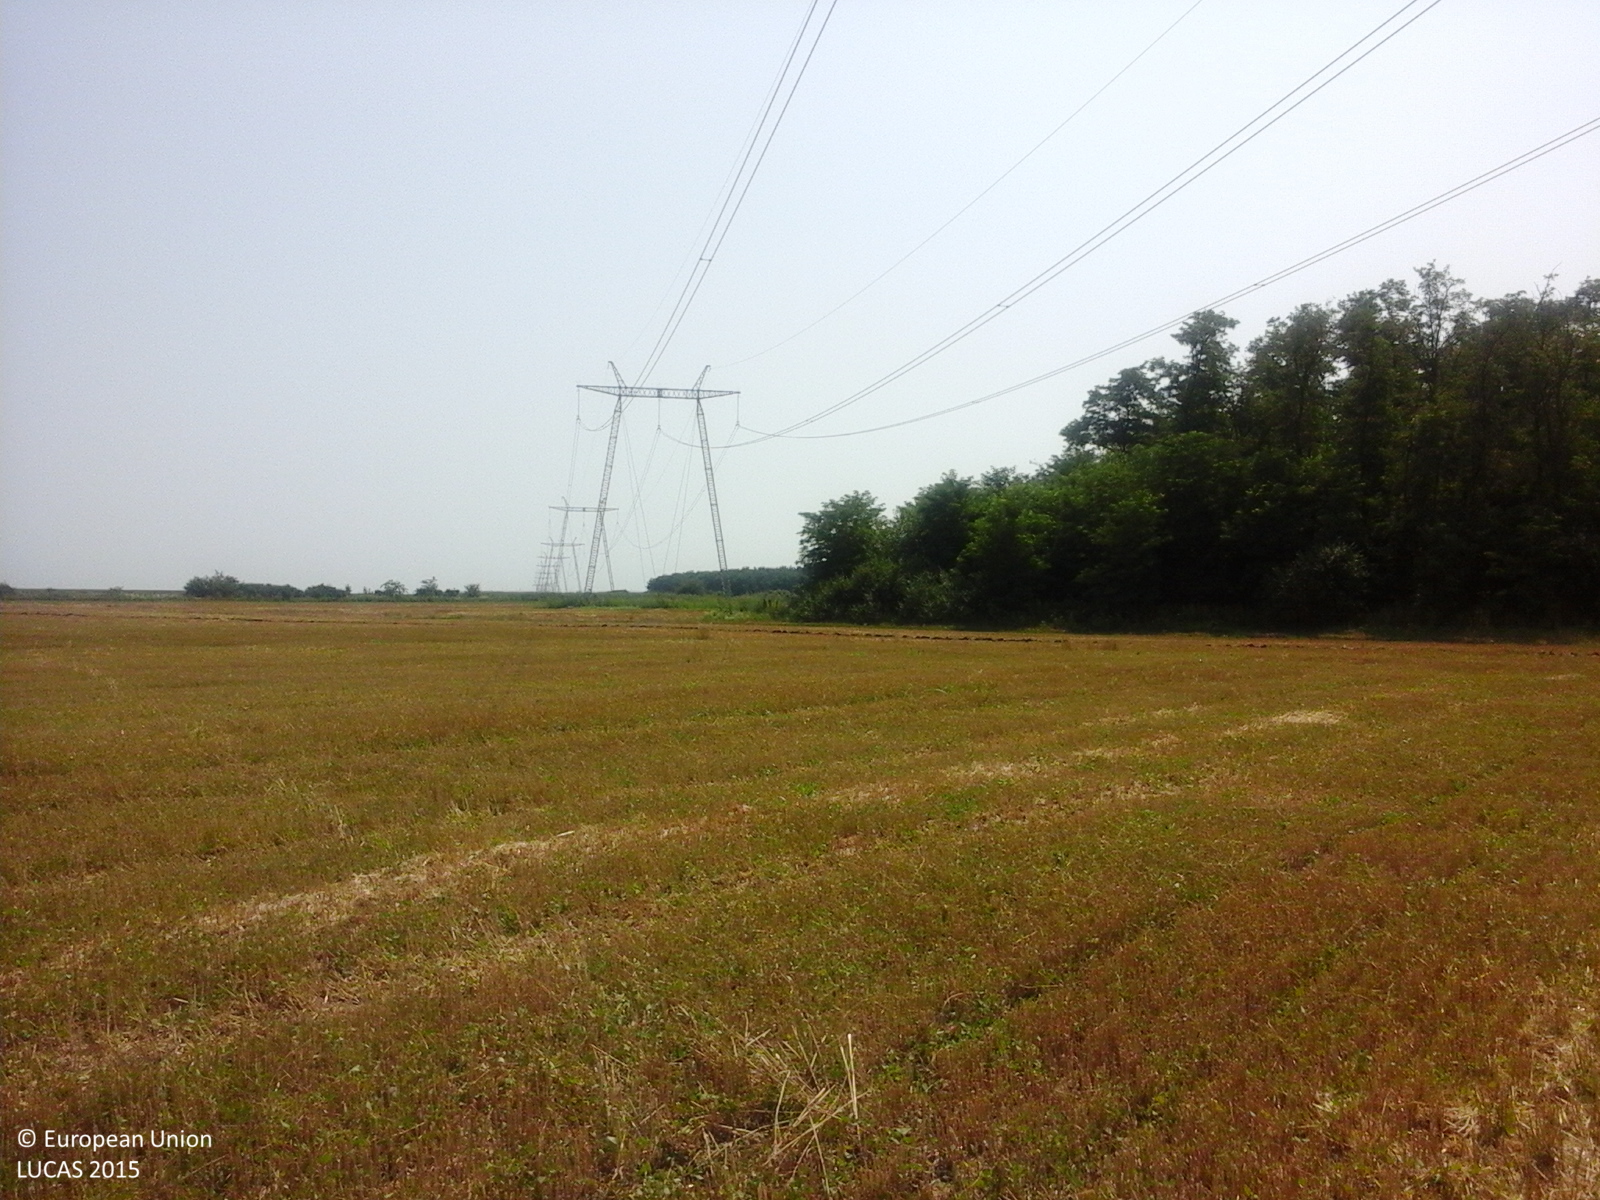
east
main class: Cropland
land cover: Durum wheat
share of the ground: < 10 %
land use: Agriculture (excluding fallow land and kitchen gardens)
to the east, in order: Durum wheat; Electric lines; Durum wheat; Tracks; Broadleaved woodland; Durum wheat
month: July
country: RO
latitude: 44.5431
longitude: 26.6198
